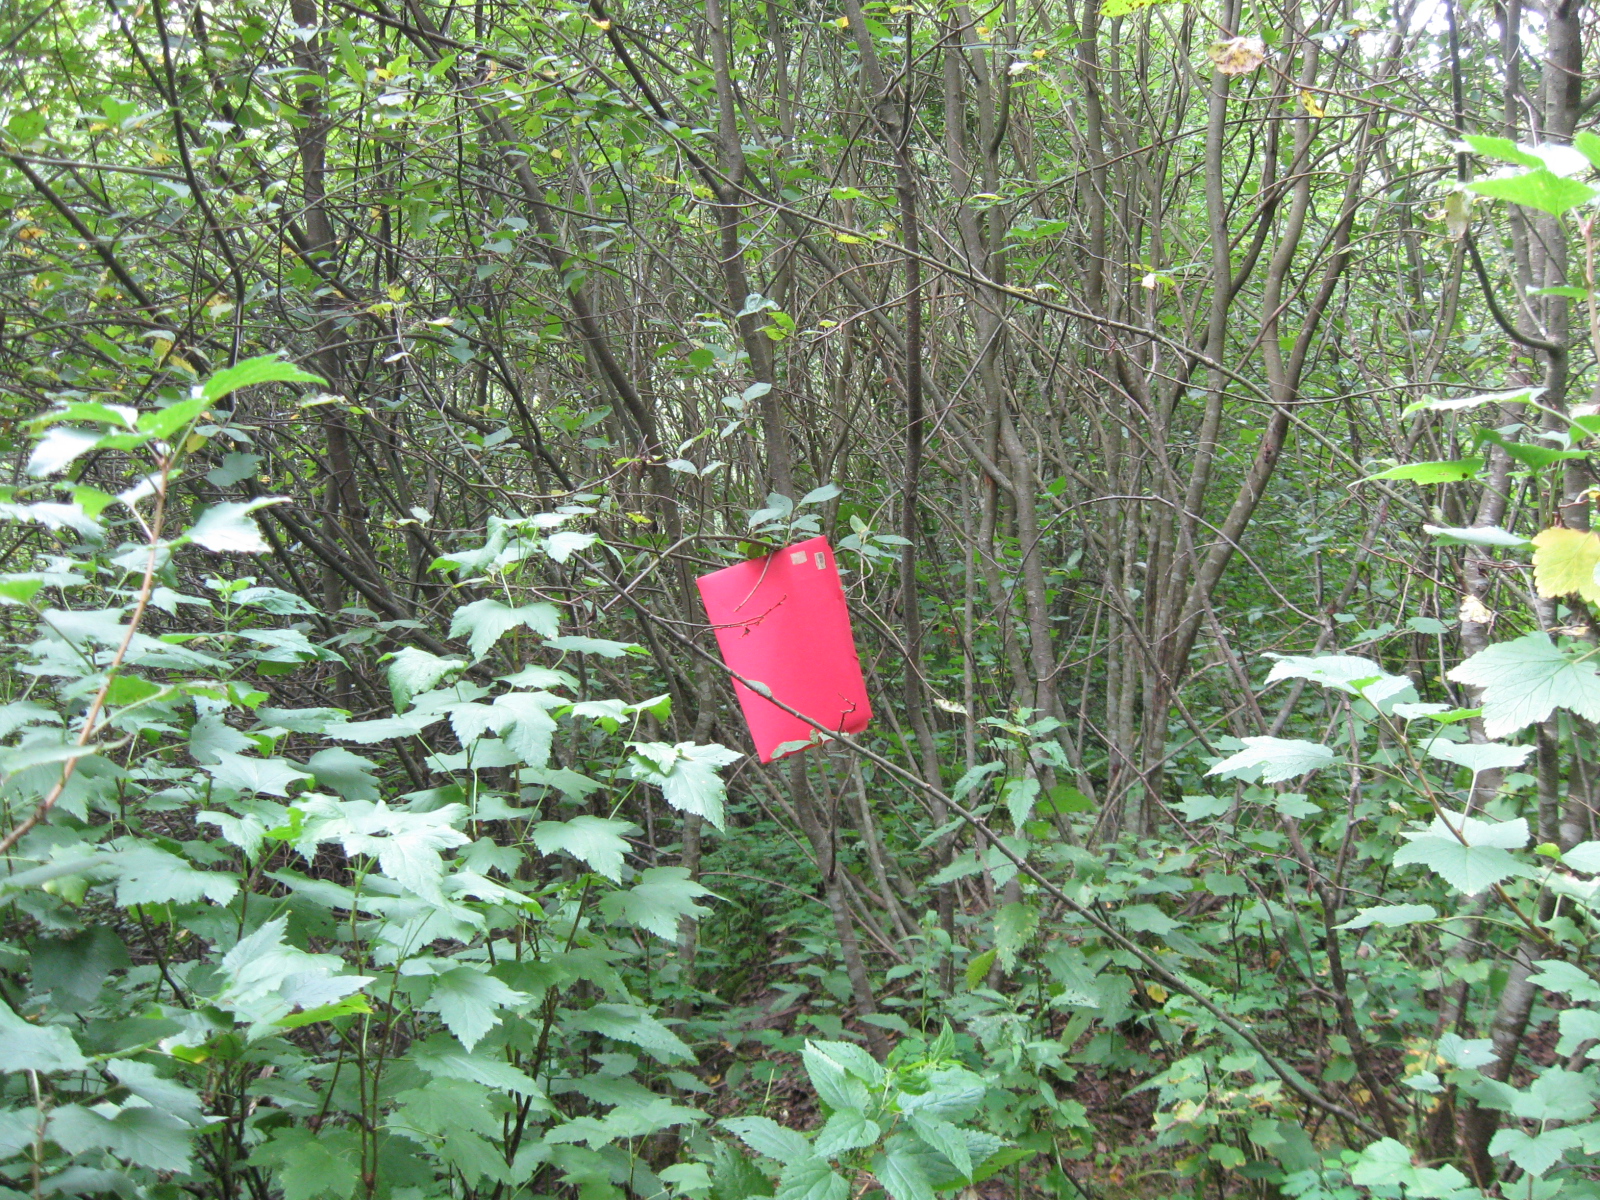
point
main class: Woodland
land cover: Broadleaved woodland
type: non-riverine alder, birch or aspen forest
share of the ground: > 75 %
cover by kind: broadleaved forest trees 85 %, herbaceous plants 10 %, coniferous forest trees 5 %
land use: Forestry
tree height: > 5 m
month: July
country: LT
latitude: 54.8611
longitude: 23.5581
